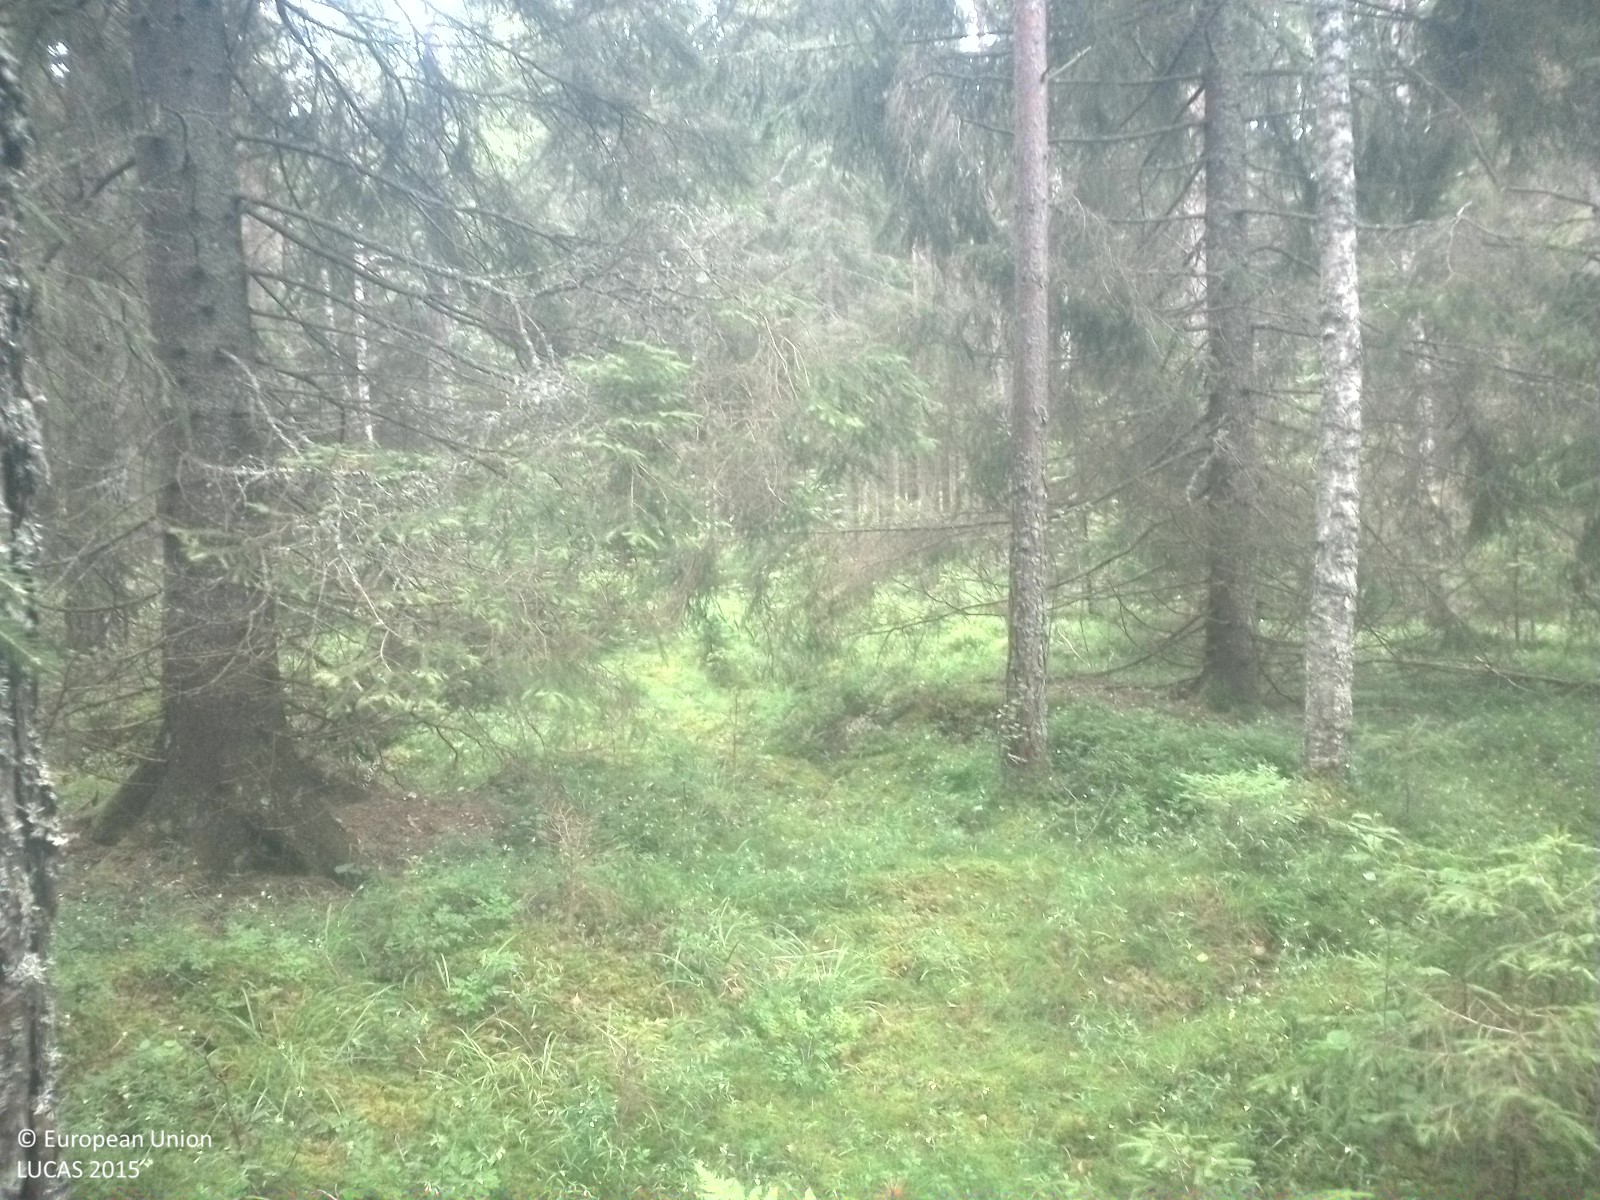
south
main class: Woodland
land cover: Other mixed woodland
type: boreal forest
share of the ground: 25 - 50 %
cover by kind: herbaceous plants 25 %, lichens and mosses 25 %, coniferous forest trees 20 %, broadleaved forest trees 20 %, shrubs 10 %
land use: Forestry
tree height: > 5 m
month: July
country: SE
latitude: 58.9194
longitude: 15.0116
